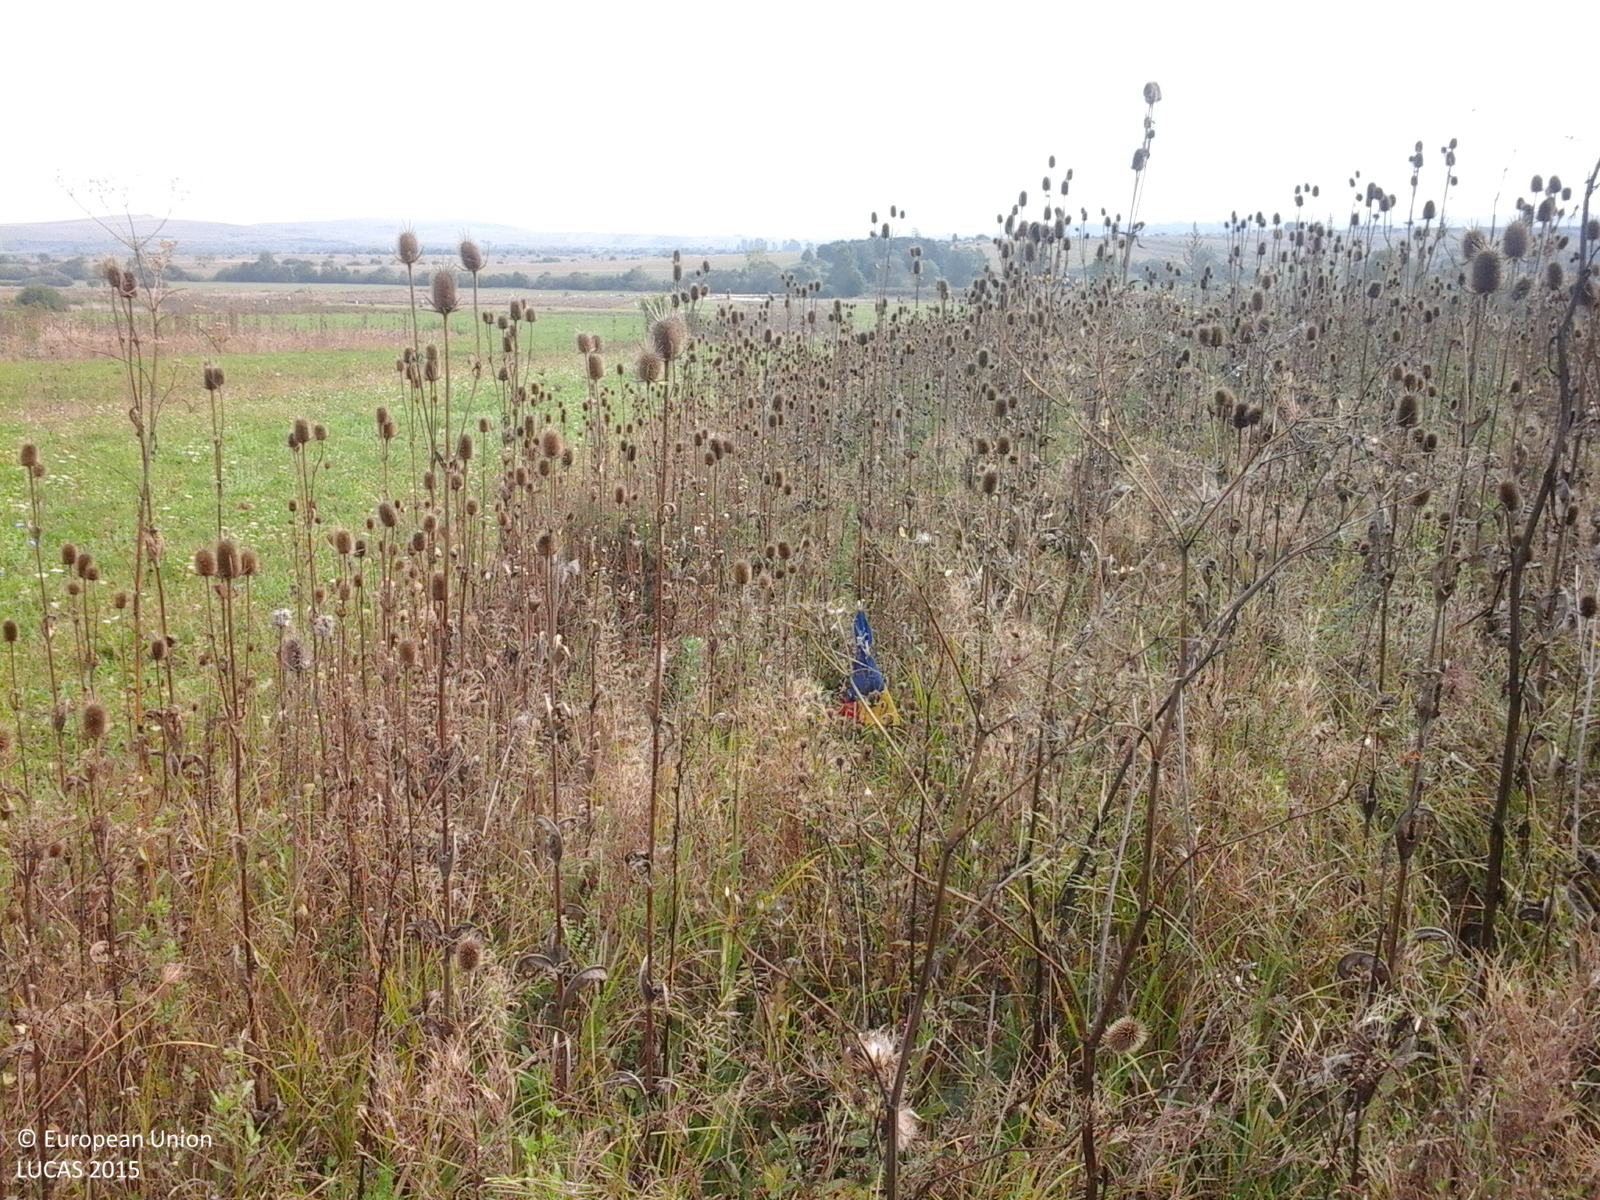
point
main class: Grassland
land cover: Spontaneously vegetated surfaces
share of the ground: > 75 %
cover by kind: herbaceous plants 100 %
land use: Fallow land
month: September
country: RO
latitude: 46.8363
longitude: 22.9488
